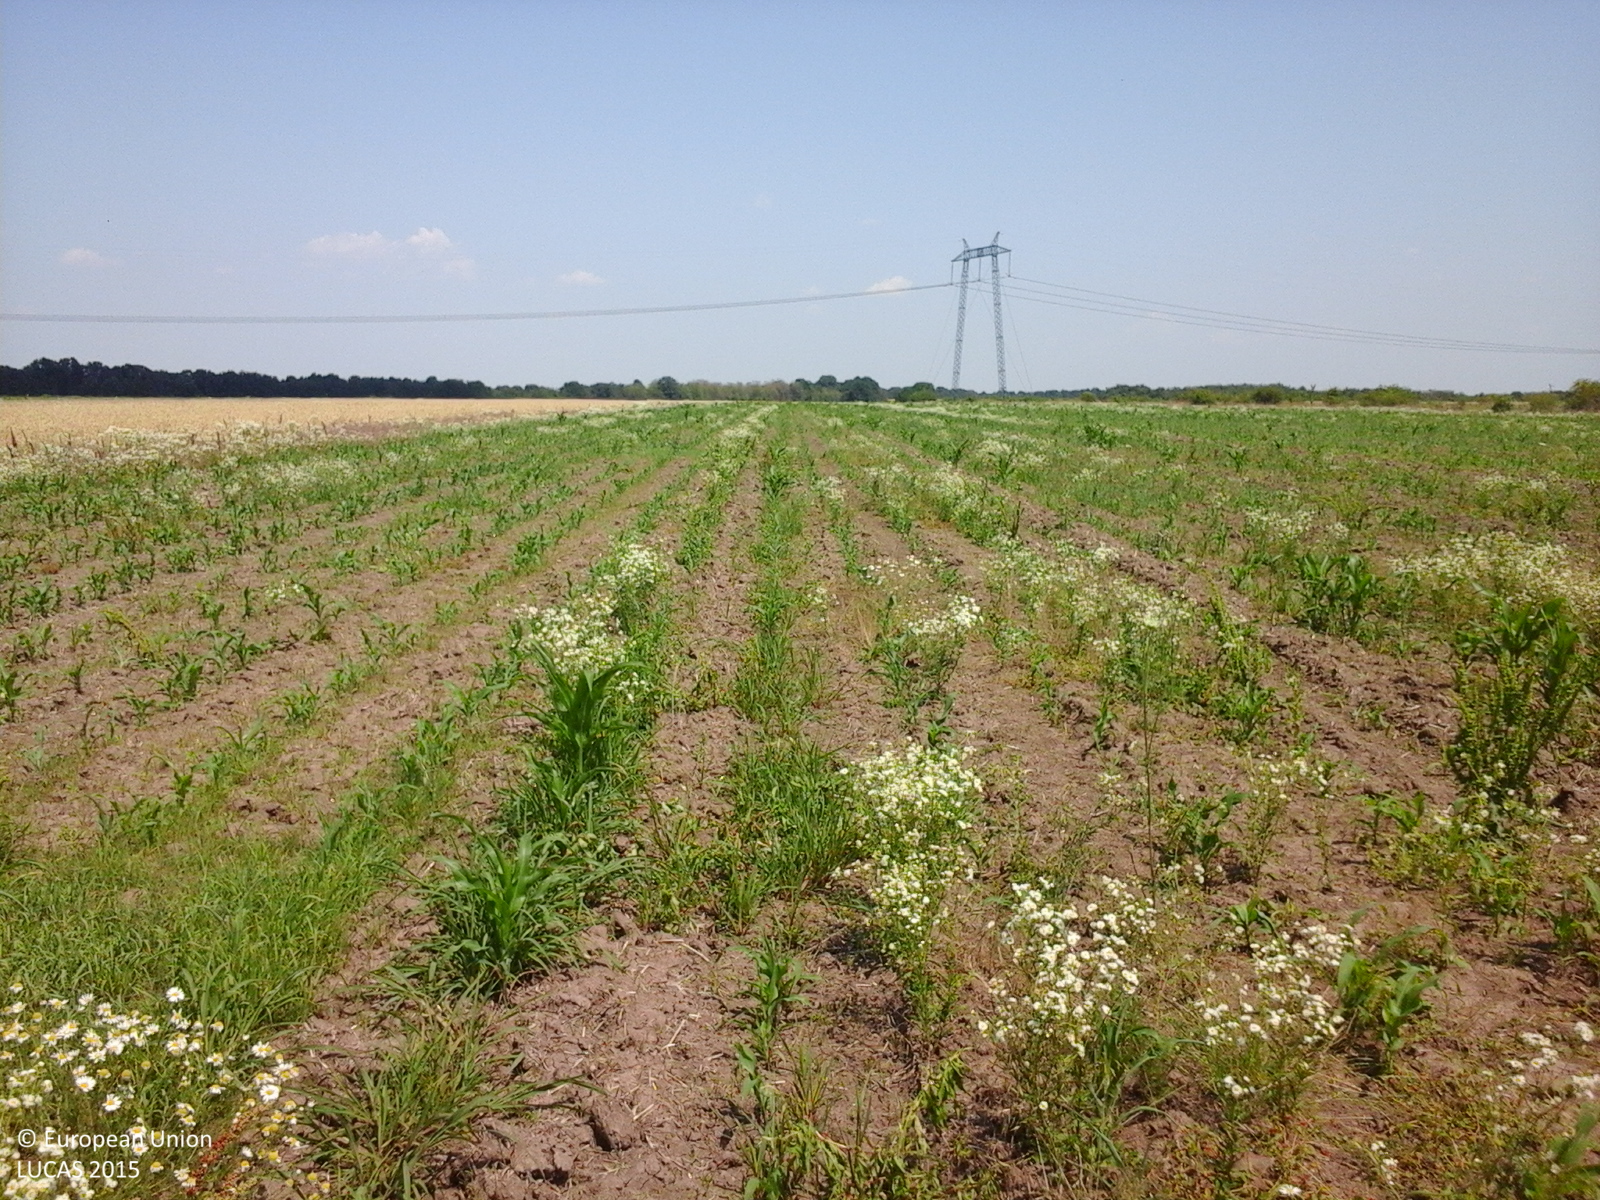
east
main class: Cropland
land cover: Maize
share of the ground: 10 - 25 %
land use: Agriculture (excluding fallow land and kitchen gardens)
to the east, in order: Maize
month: July
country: RO
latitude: 44.6494
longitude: 24.7159
